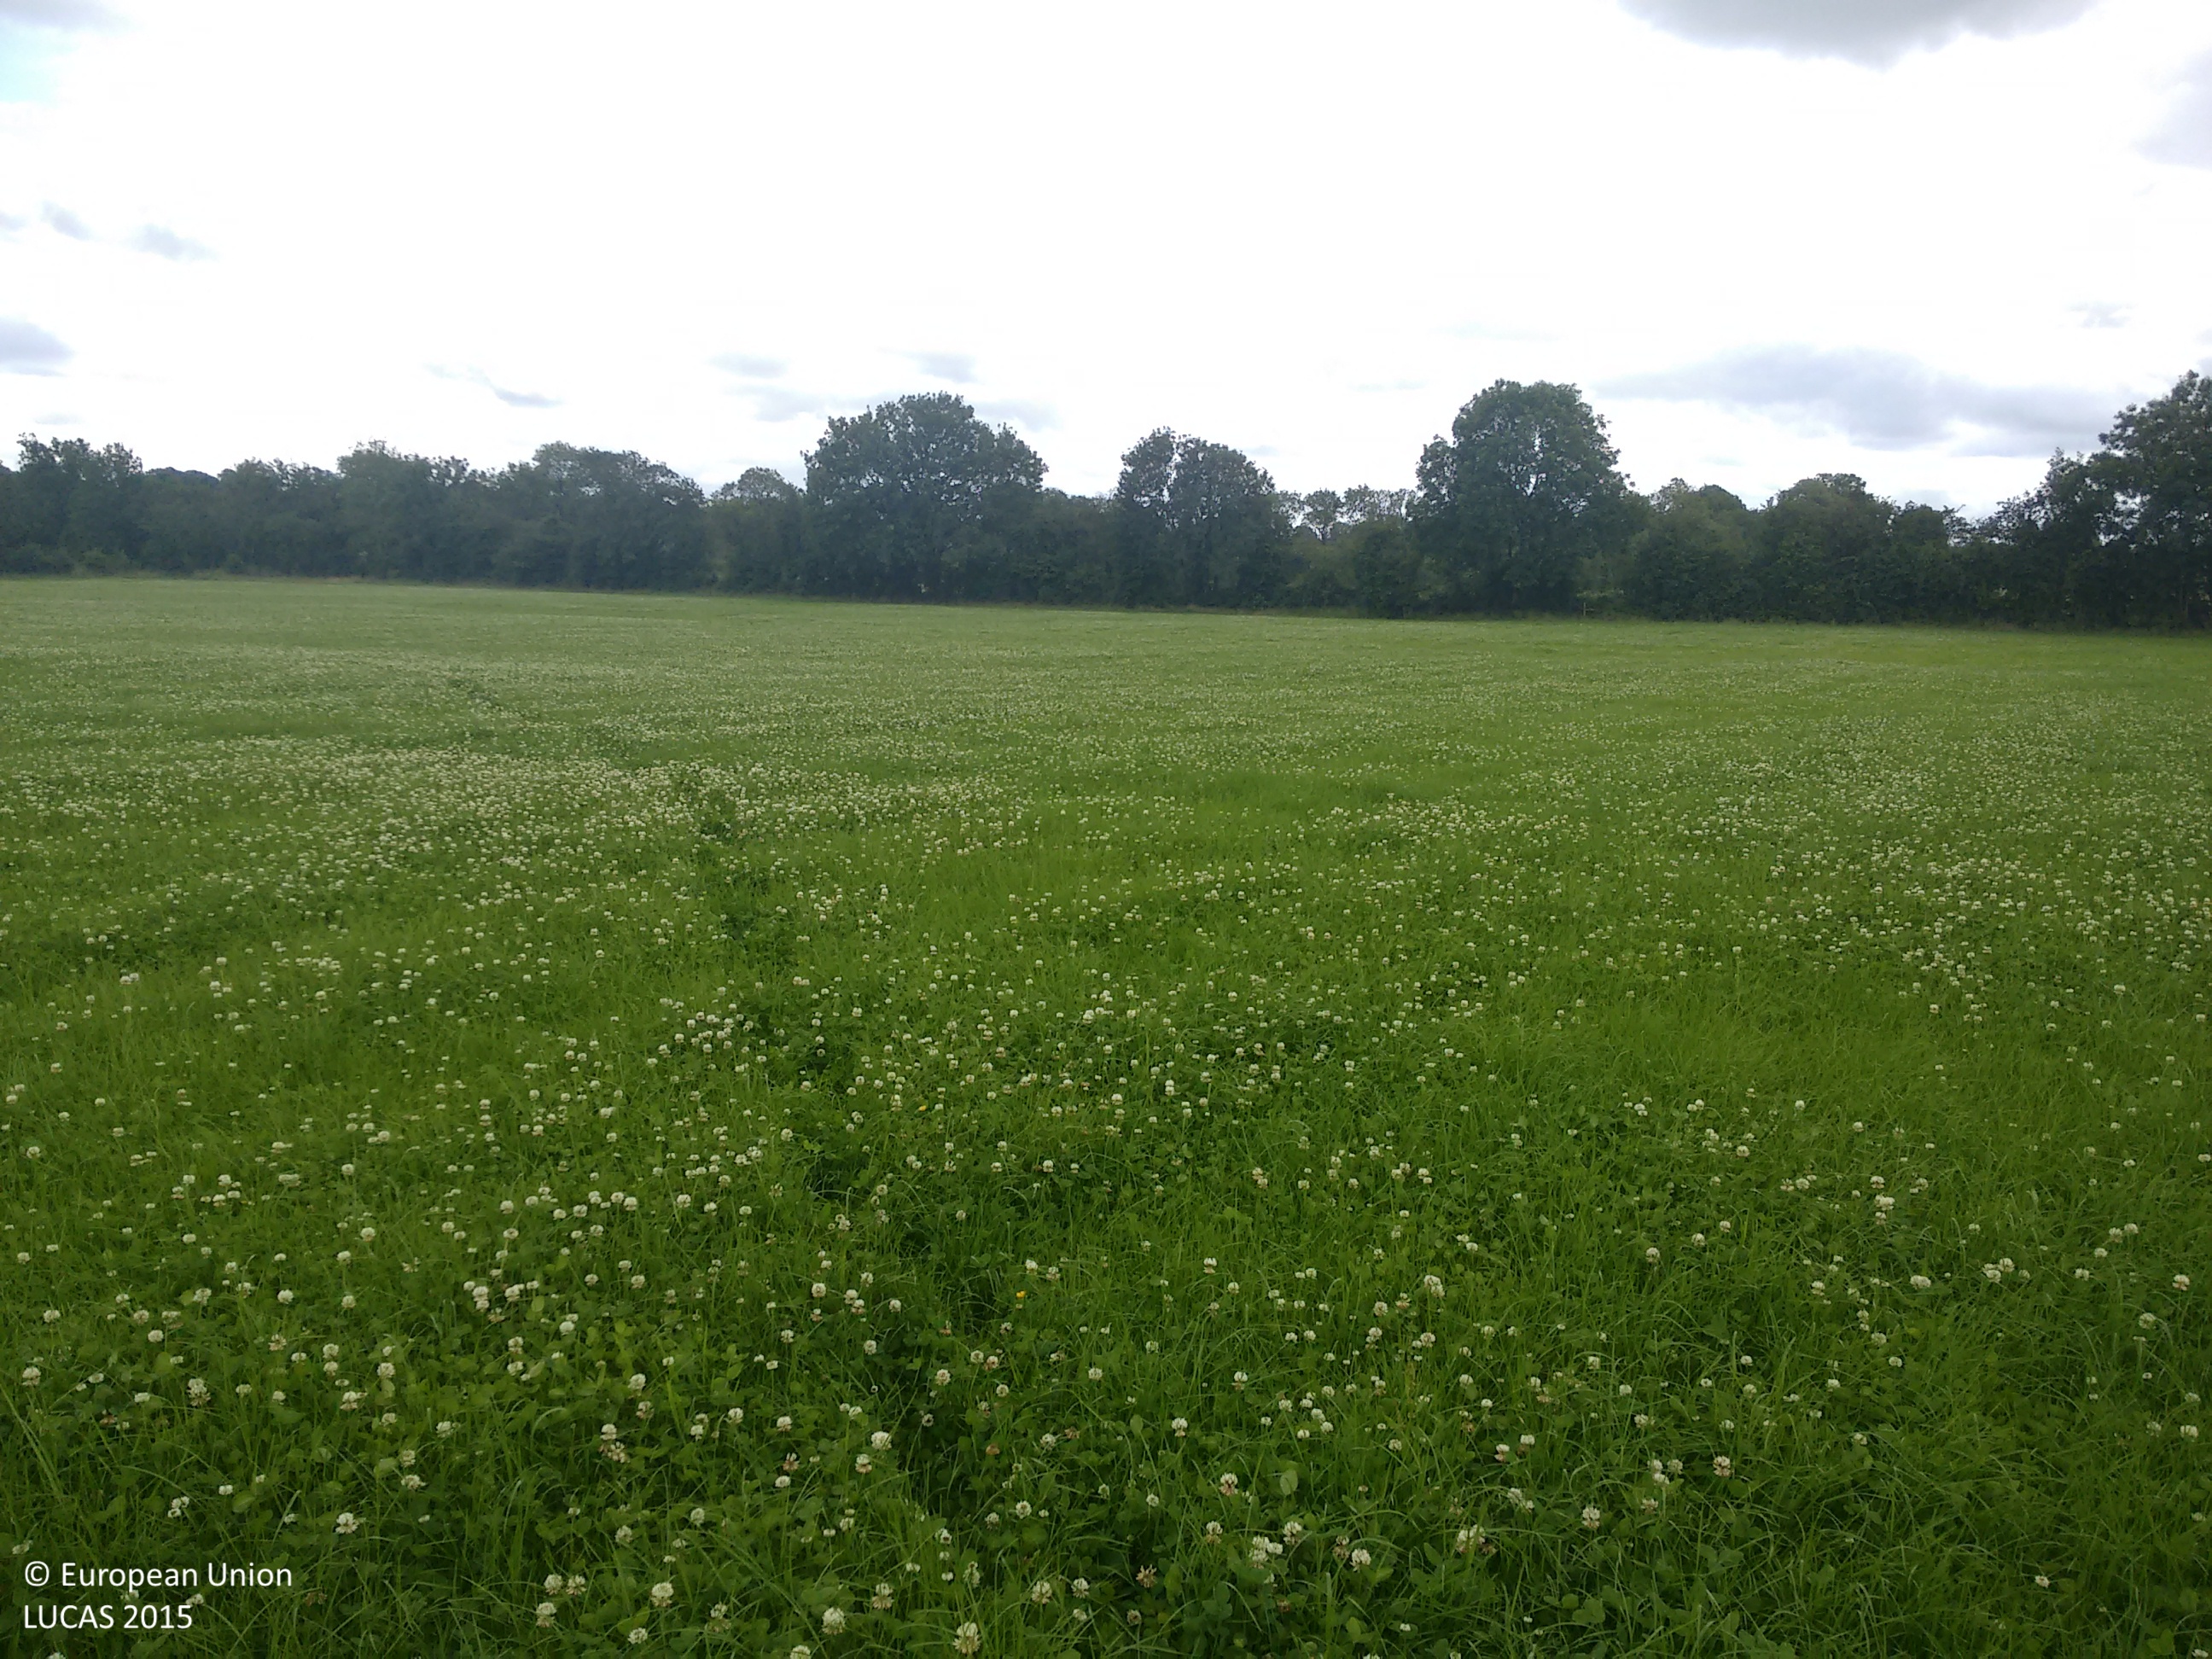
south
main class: Cropland
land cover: Temporary grasslands
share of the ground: > 75 %
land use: Agriculture (excluding fallow land and kitchen gardens)
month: July
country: IE
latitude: 53.4981
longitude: -7.7278
